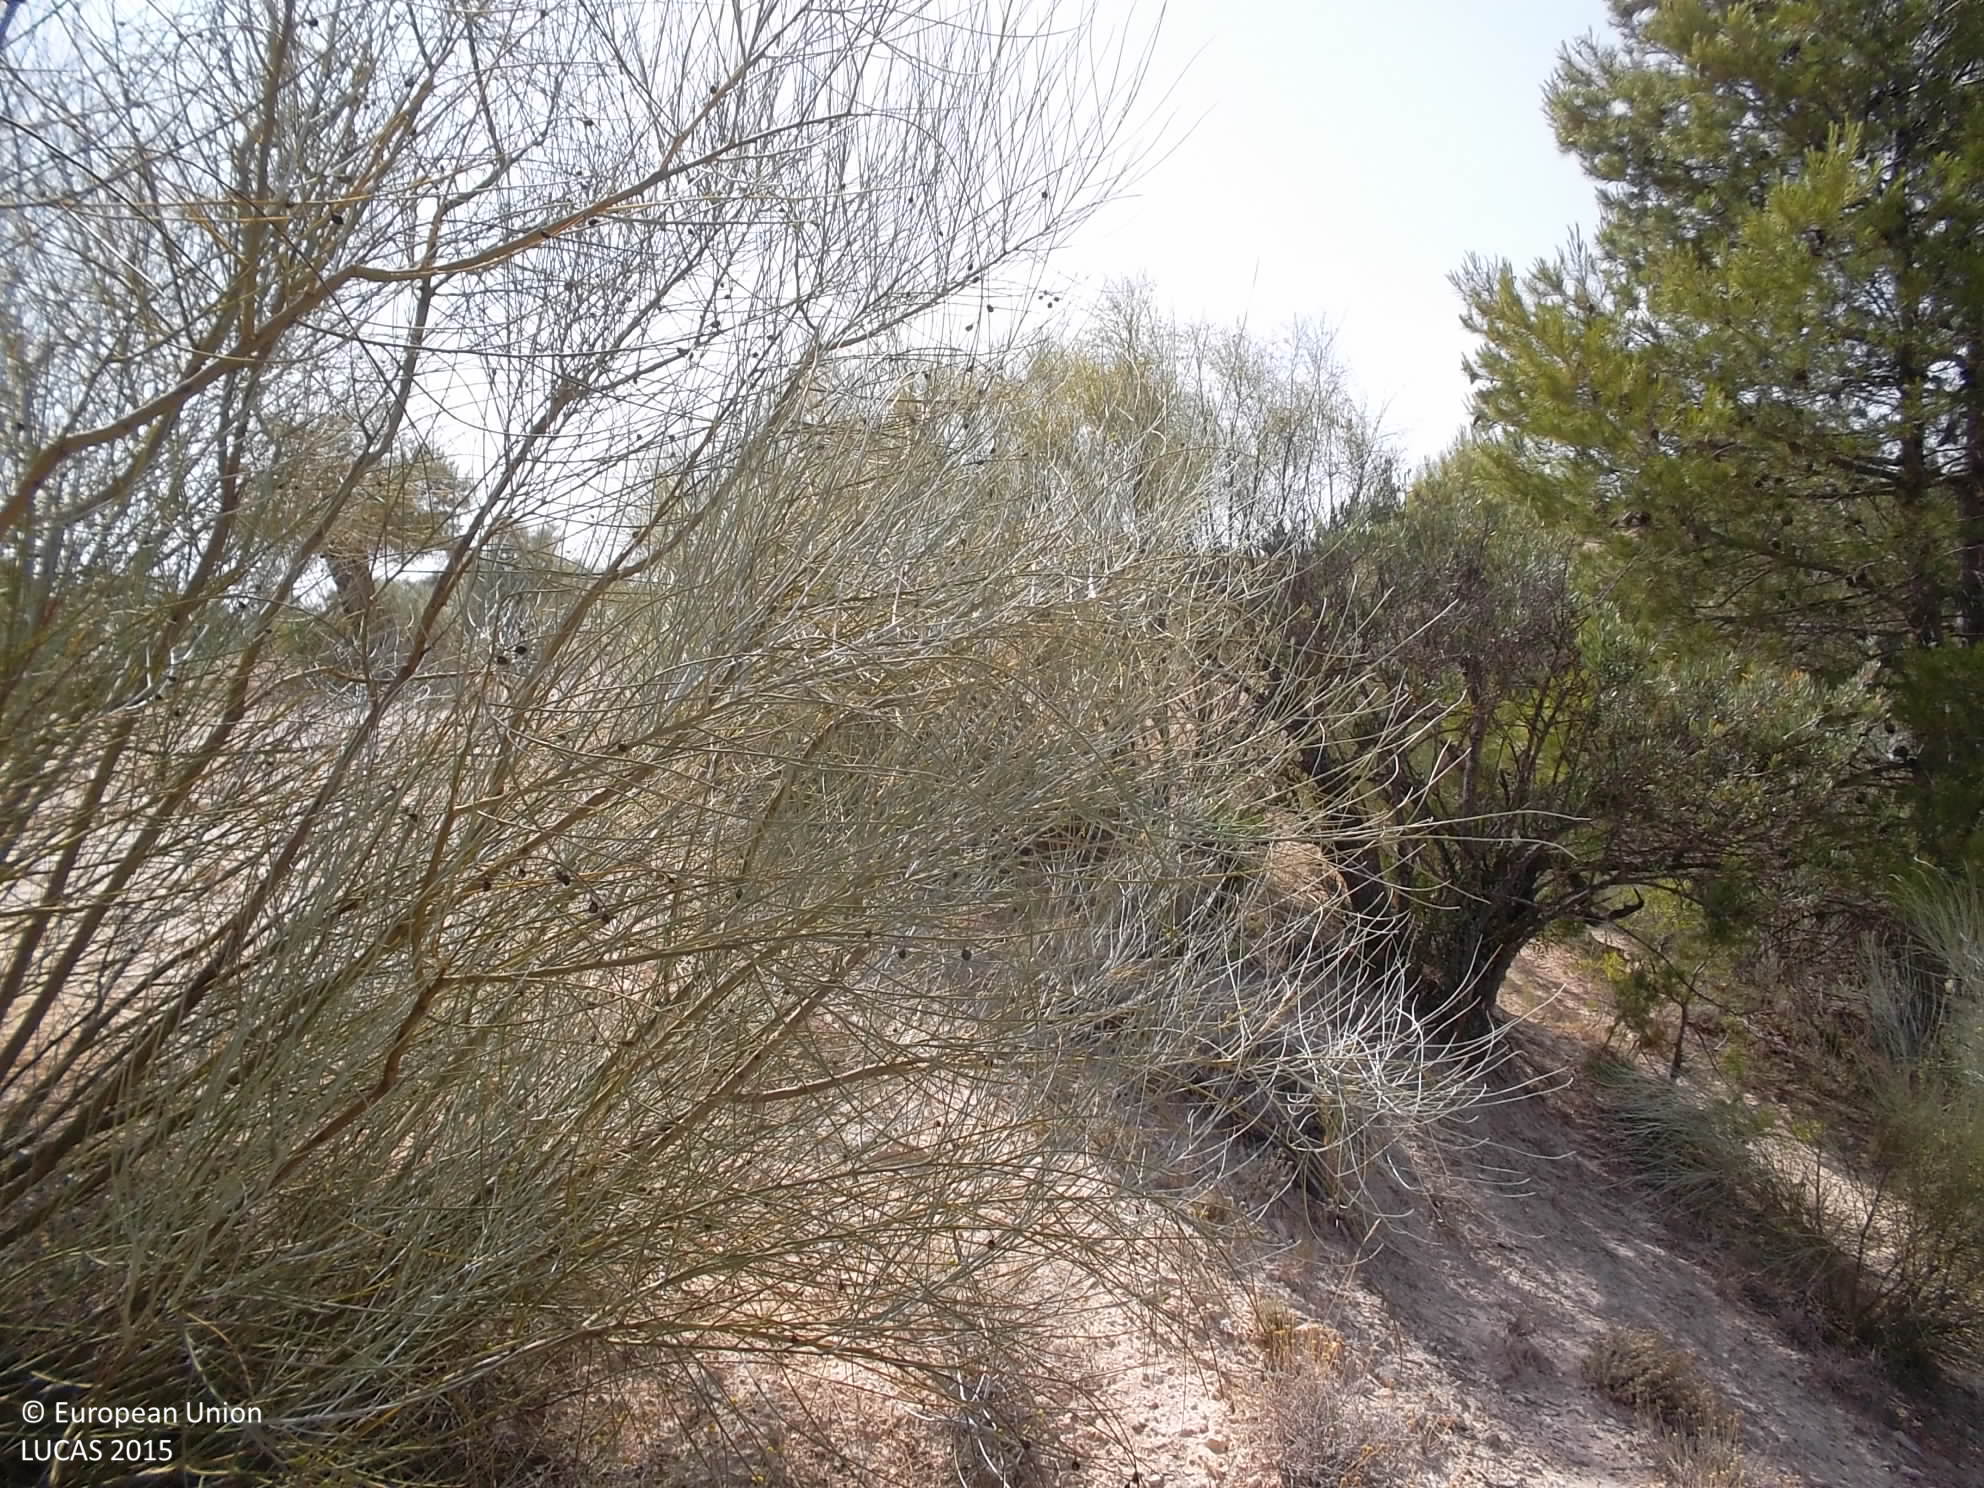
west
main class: Cropland
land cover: Olive groves
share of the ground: 10 - 25 %
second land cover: Spontaneously vegetated surfaces
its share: 25 - 50 %
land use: Agriculture (excluding fallow land and kitchen gardens)
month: June
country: ES
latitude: 37.7340
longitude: -2.8474
